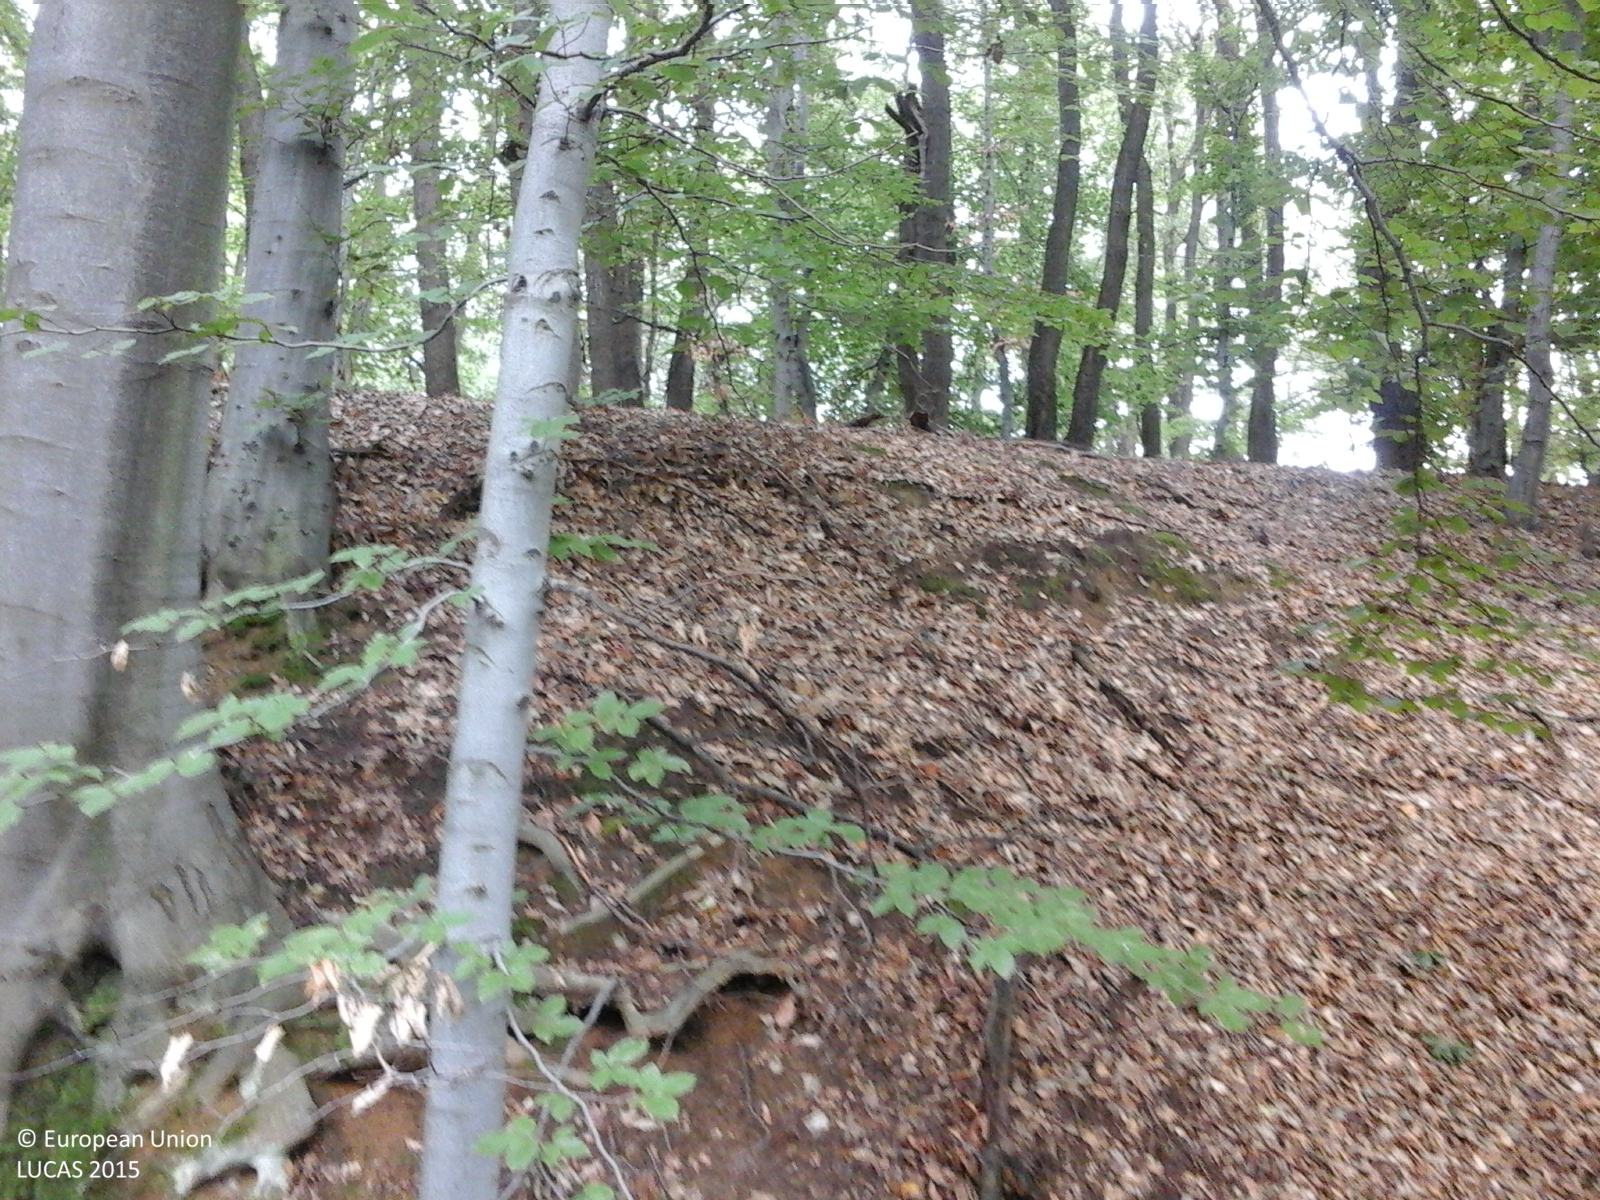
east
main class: Woodland
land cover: Broadleaved woodland
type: acidophilous oak and oak-birch forest
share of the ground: > 75 %
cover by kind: broadleaved forest trees 100 %
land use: Forestry
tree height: > 5 m
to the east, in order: Broadleaved woodland
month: September
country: RO
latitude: 45.8402
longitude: 23.3351
